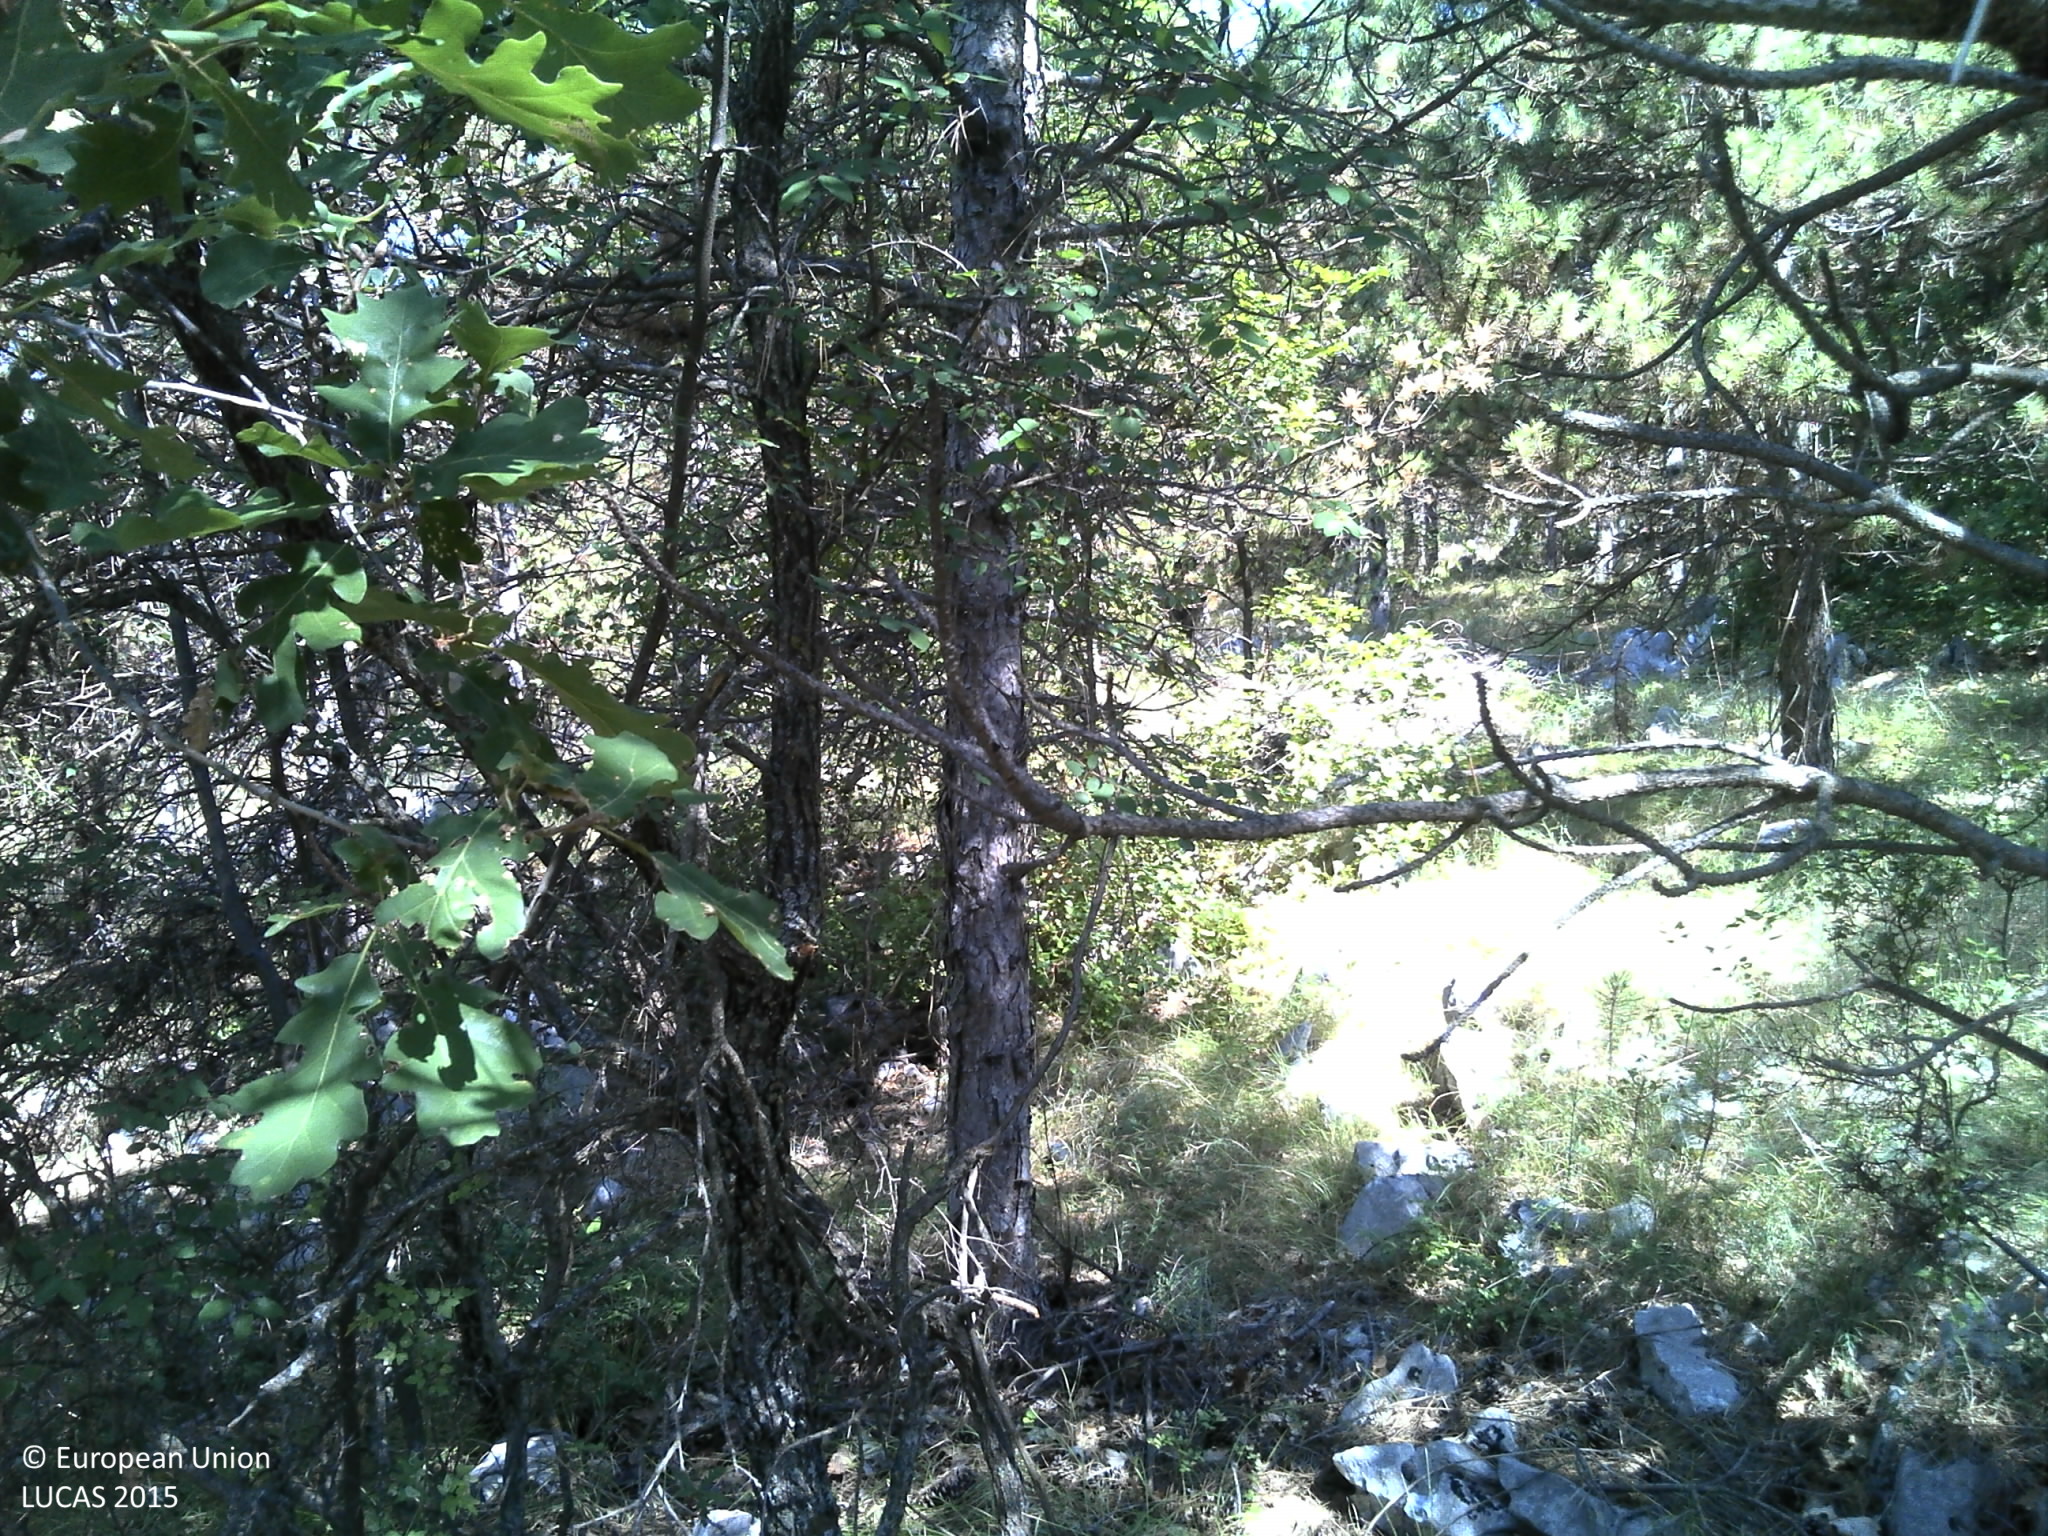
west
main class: Woodland
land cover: Pine dominated coniferous woodland
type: coniferous forest of the mediterranean region
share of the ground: > 75 %
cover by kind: coniferous forest trees 80 %, shrubs 10 %, herbaceous plants 5 %, consolidated bare surface 5 %
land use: Semi-natural and natural areas not in use
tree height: > 5 m
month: July
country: HR
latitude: 43.4684
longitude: 17.1737
